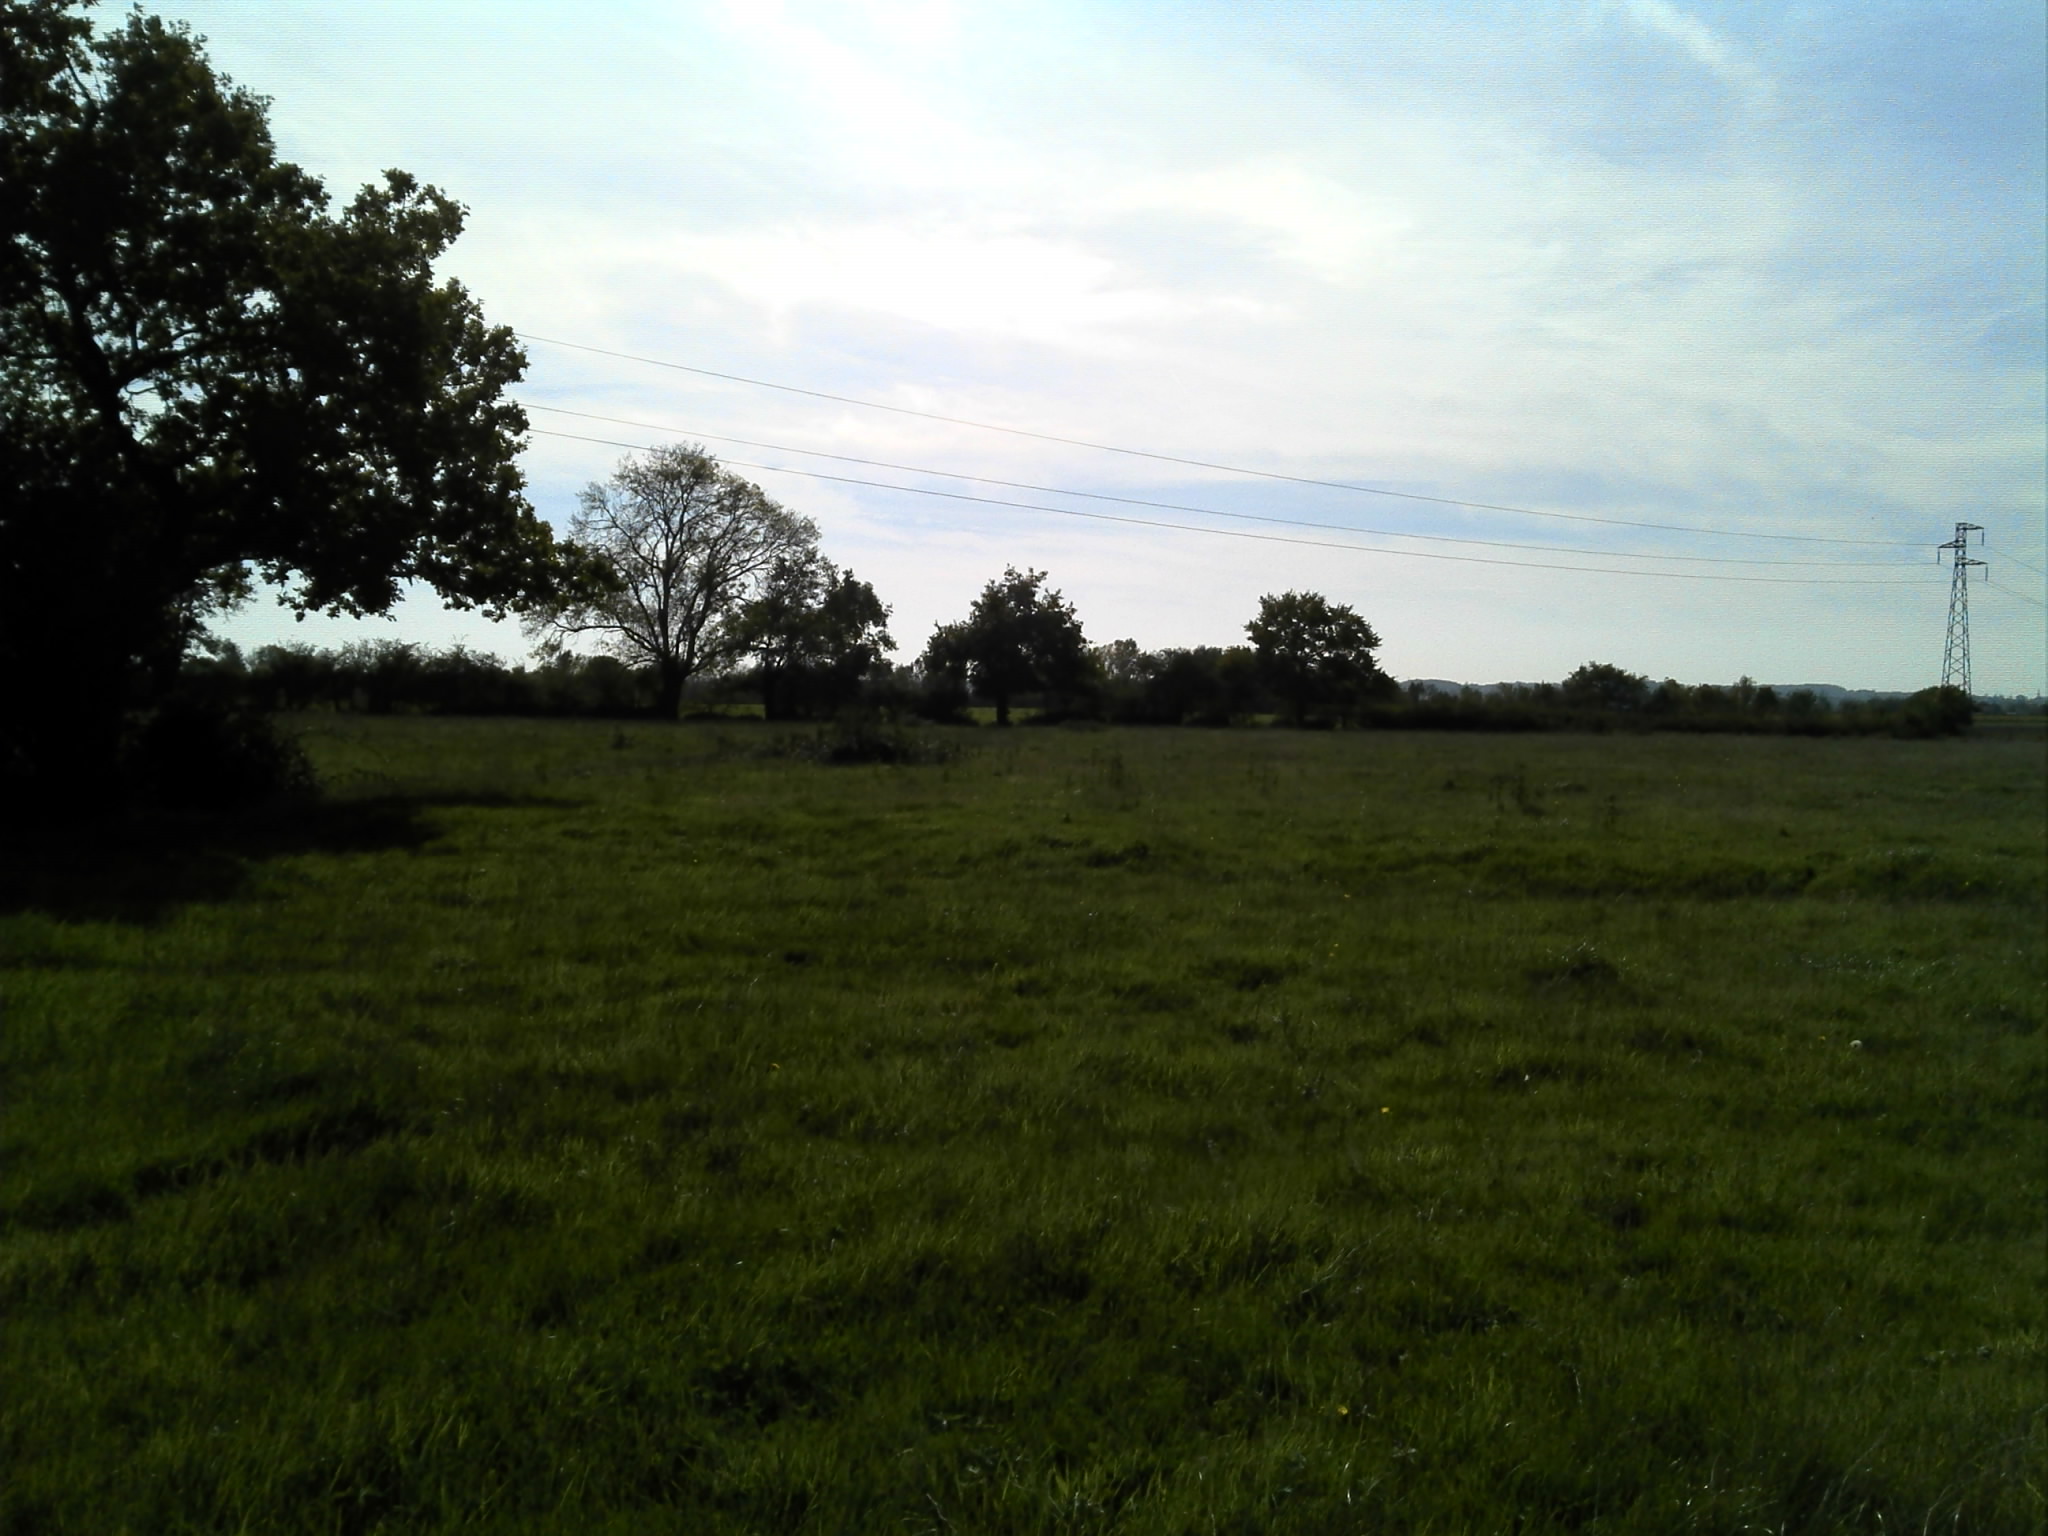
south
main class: Grassland
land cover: Grassland without tree/shrub cover
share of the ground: > 75 %
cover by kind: herbaceous plants 100 %
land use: Agriculture (excluding fallow land and kitchen gardens)
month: October
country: FR
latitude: 47.3165
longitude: -1.2707
